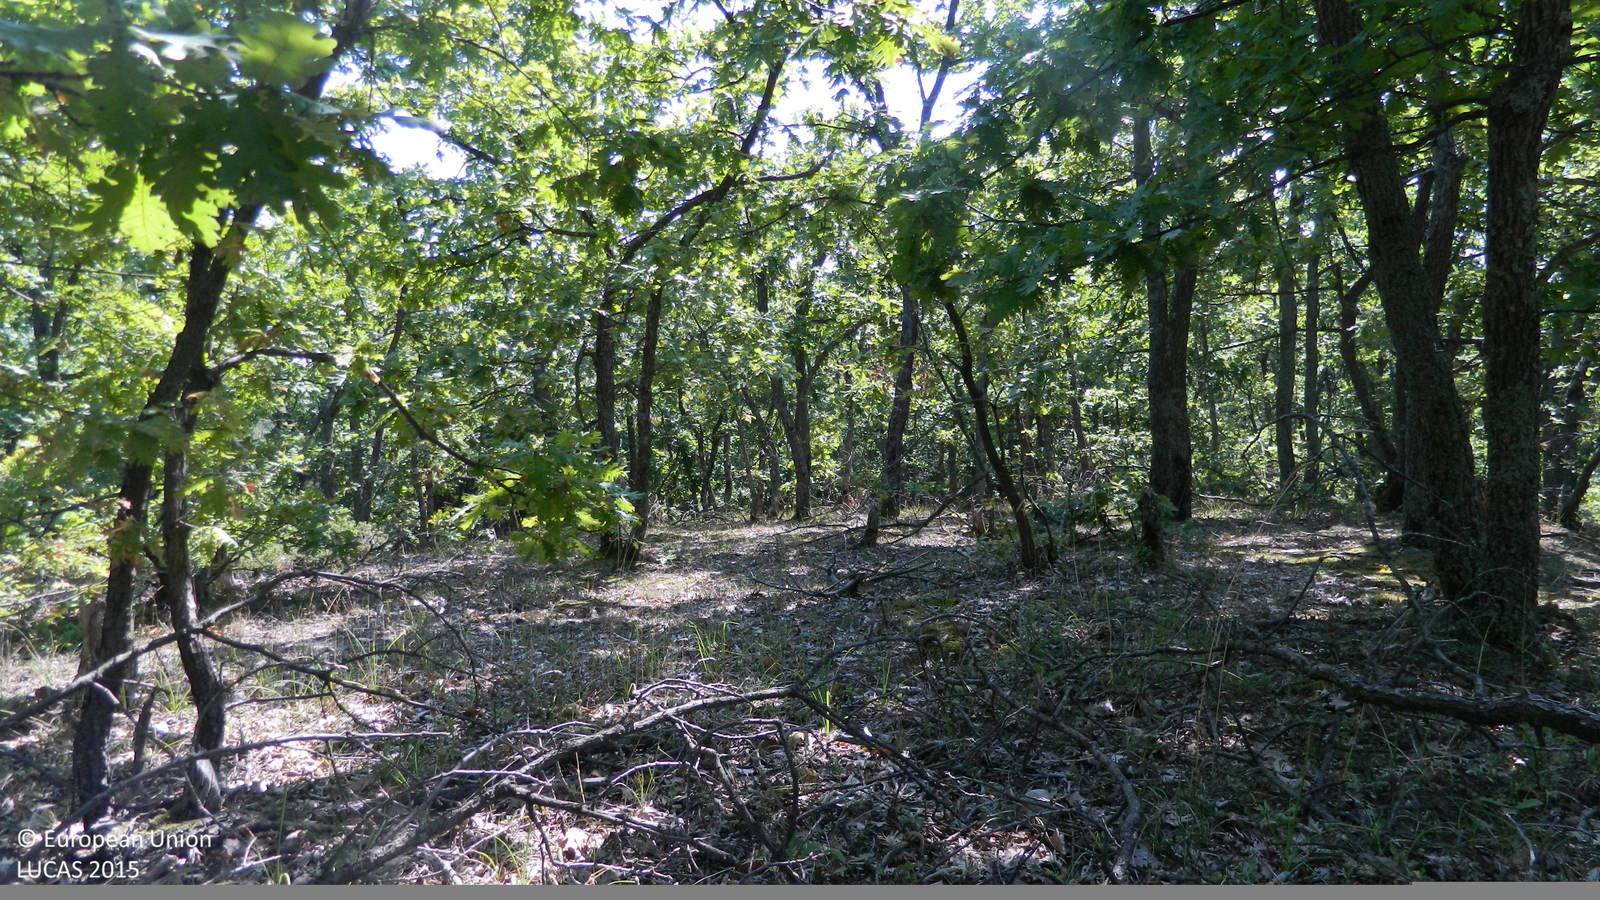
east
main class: Woodland
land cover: Broadleaved woodland
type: thermophilous deciduous forest
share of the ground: > 75 %
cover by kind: broadleaved forest trees 85 %, herbaceous plants 10 %, unconsolidated bare surface 5 %
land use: Forestry
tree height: > 5 m
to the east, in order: Broadleaved woodland; Rivers and streams; Broadleaved woodland; Shrubland with sparse tree cover; Tracks; Shrubland with sparse tree cover; Broadleaved woodland; Tracks; Shrubland with sparse tree cover; Grassland with sparse tree/shrub cover; Tracks; Grassland with sparse tree/shrub cover
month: September
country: BG
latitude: 41.6829
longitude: 25.6686
